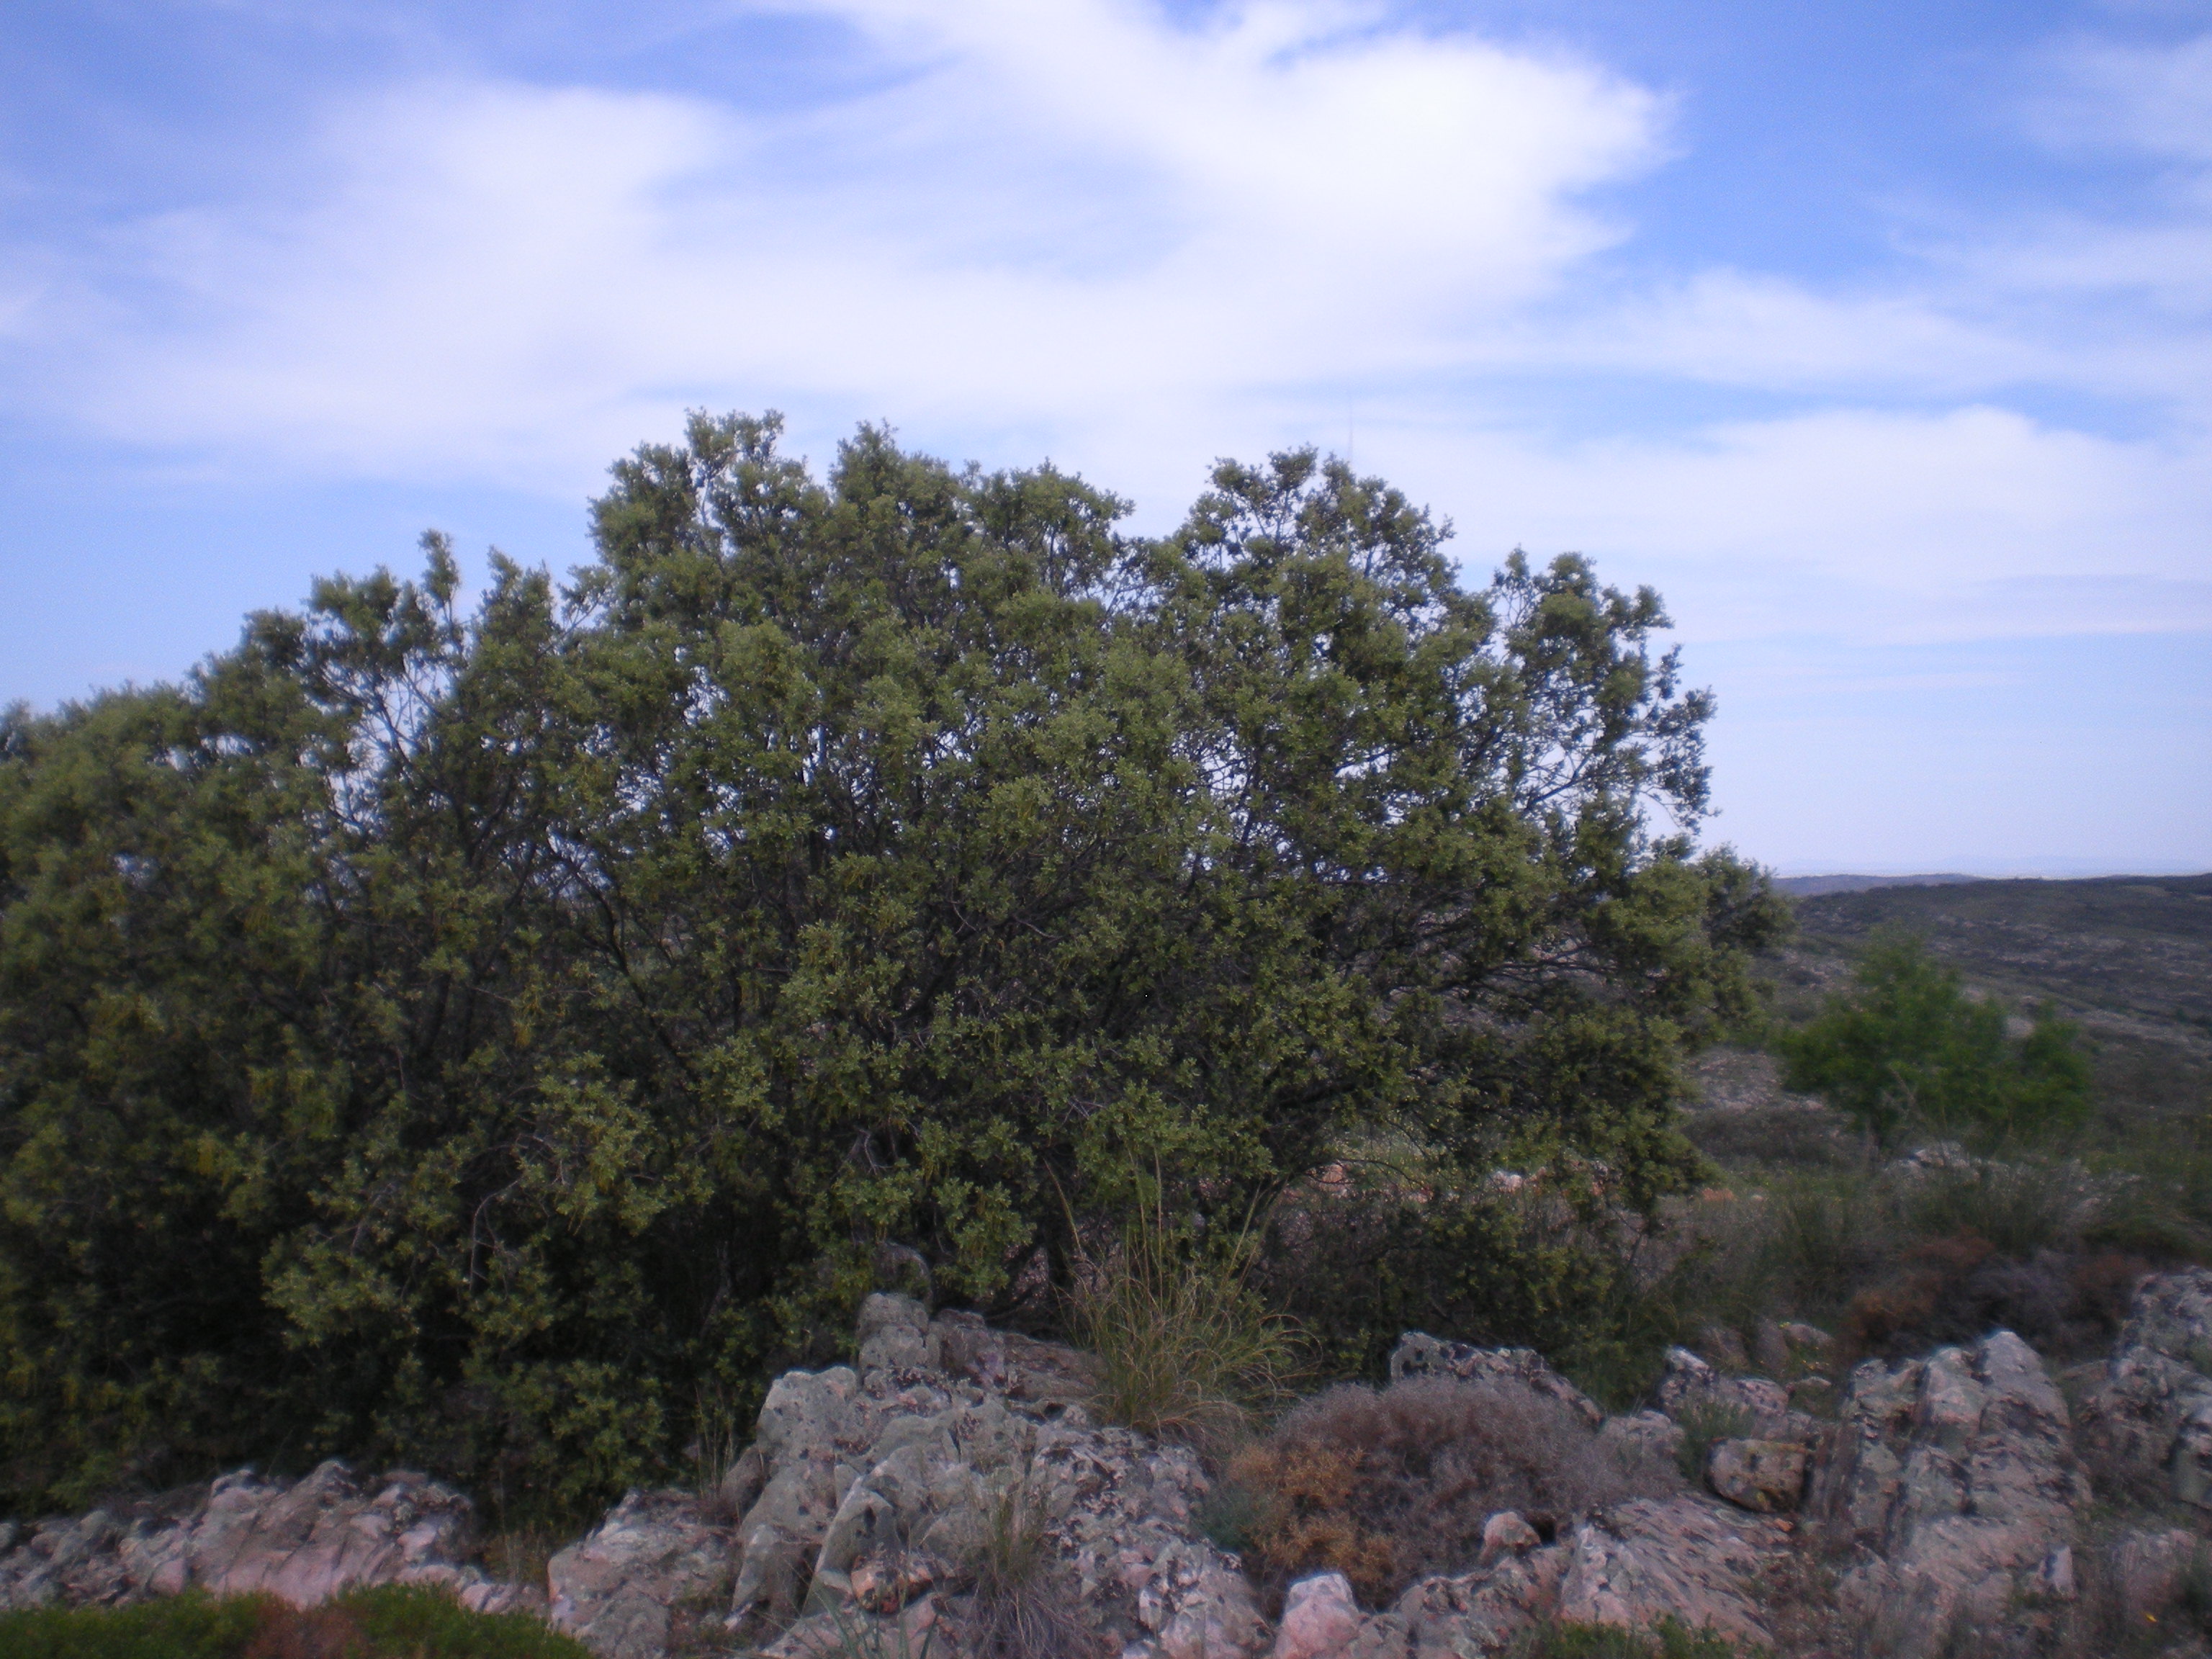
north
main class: Shrubland
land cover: Shrubland without tree cover
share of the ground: 10 - 25 %
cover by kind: herbaceous plants 50 %, consolidated bare surface 40 %, shrubs 10 %
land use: Semi-natural and natural areas not in use
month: April
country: ES
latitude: 38.8425
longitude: -3.5747
